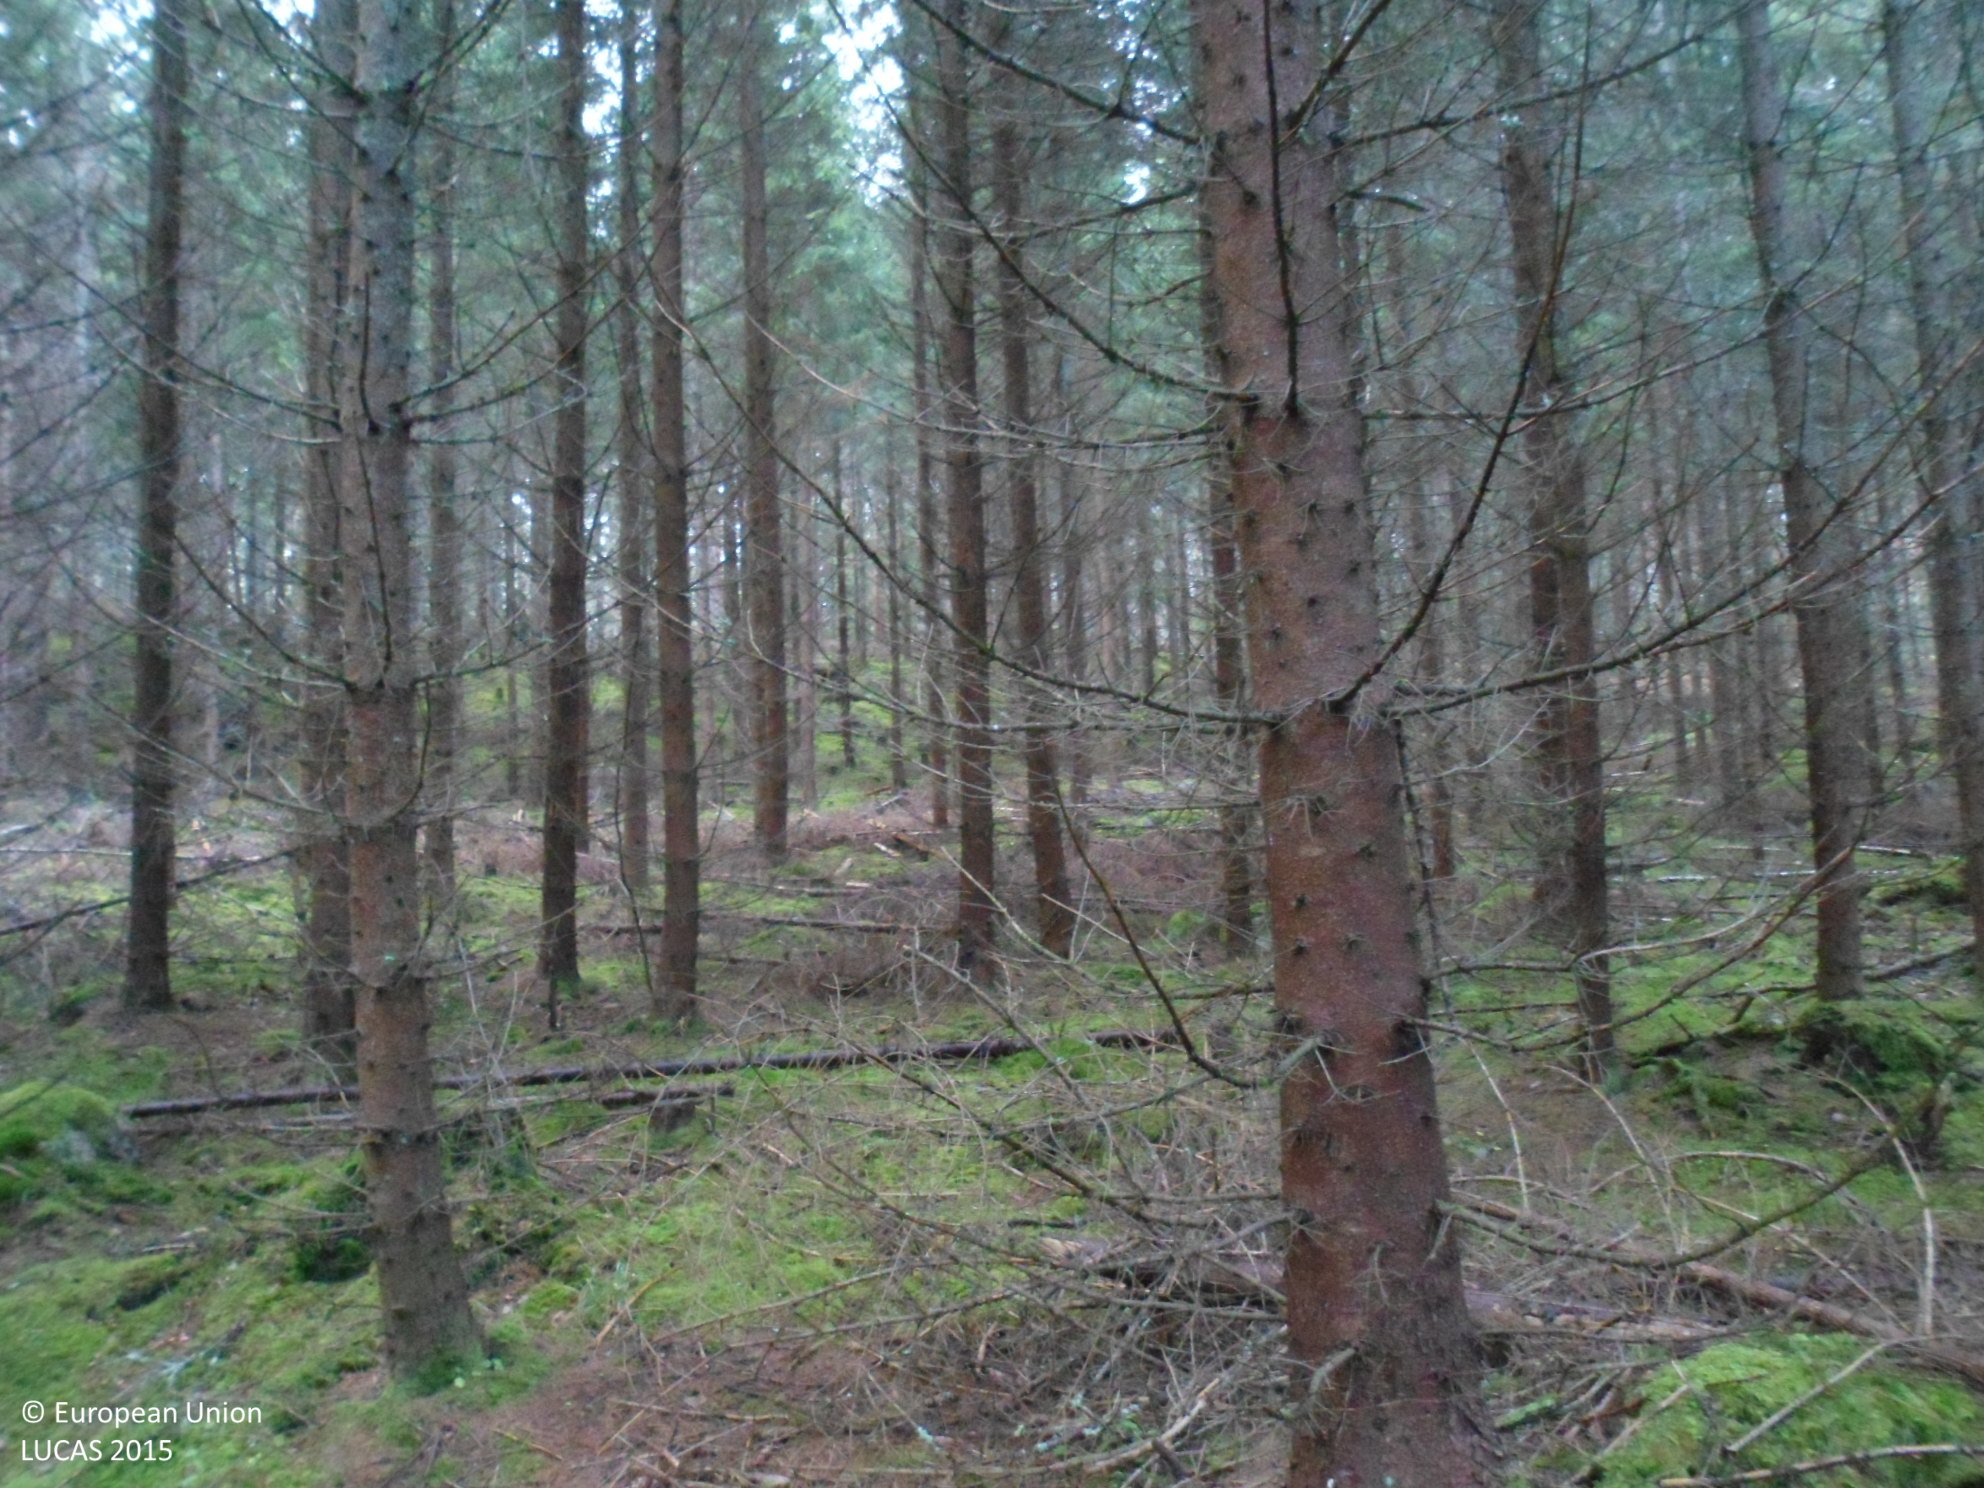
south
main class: Woodland
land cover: Spruce dominated coniferous woodland
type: boreal forest
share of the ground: 50 - 75 %
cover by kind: coniferous forest trees 60 %, lichens and mosses 30 %, shrubs 5 %, unconsolidated bare surface 5 %
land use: Forestry
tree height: > 5 m
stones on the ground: 25 - 50 %
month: November
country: SE
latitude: 57.6744
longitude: 15.9160
